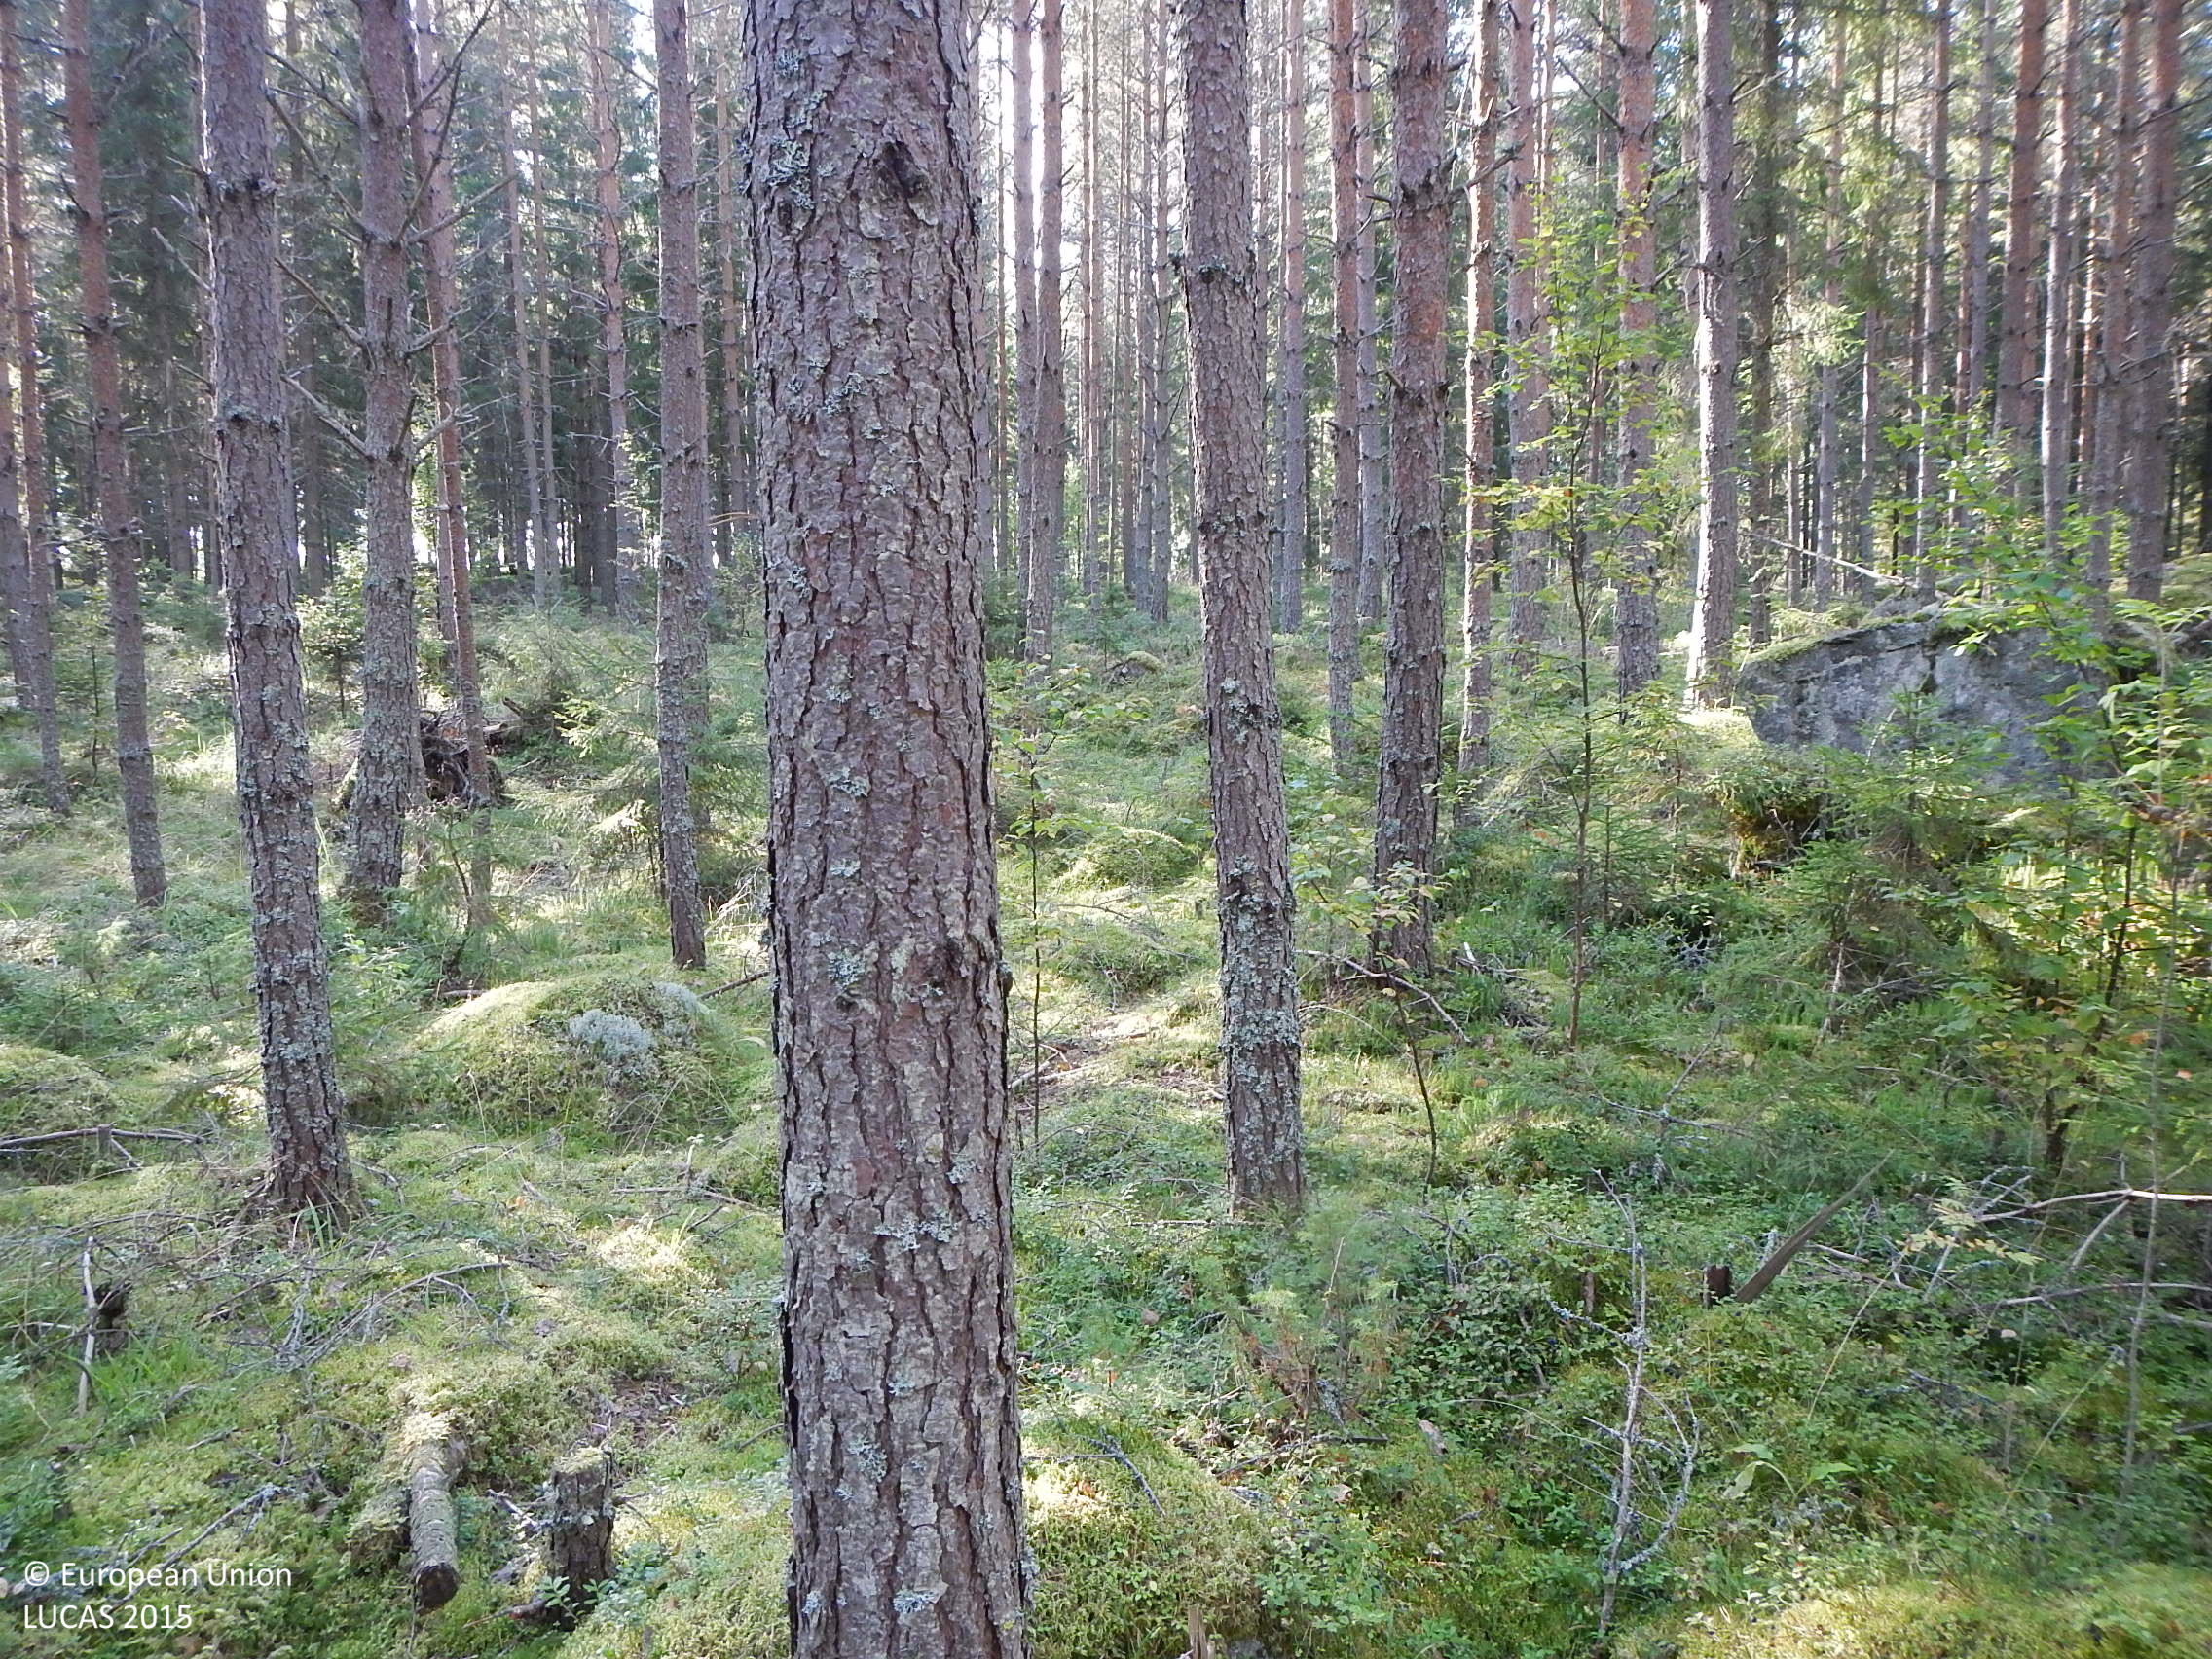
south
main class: Woodland
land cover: Pine dominated coniferous woodland
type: boreal forest
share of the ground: > 75 %
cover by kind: coniferous forest trees 75 %, lichens and mosses 25 %
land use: Forestry
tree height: > 5 m
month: September
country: FI
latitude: 61.6250
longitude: 22.1485
